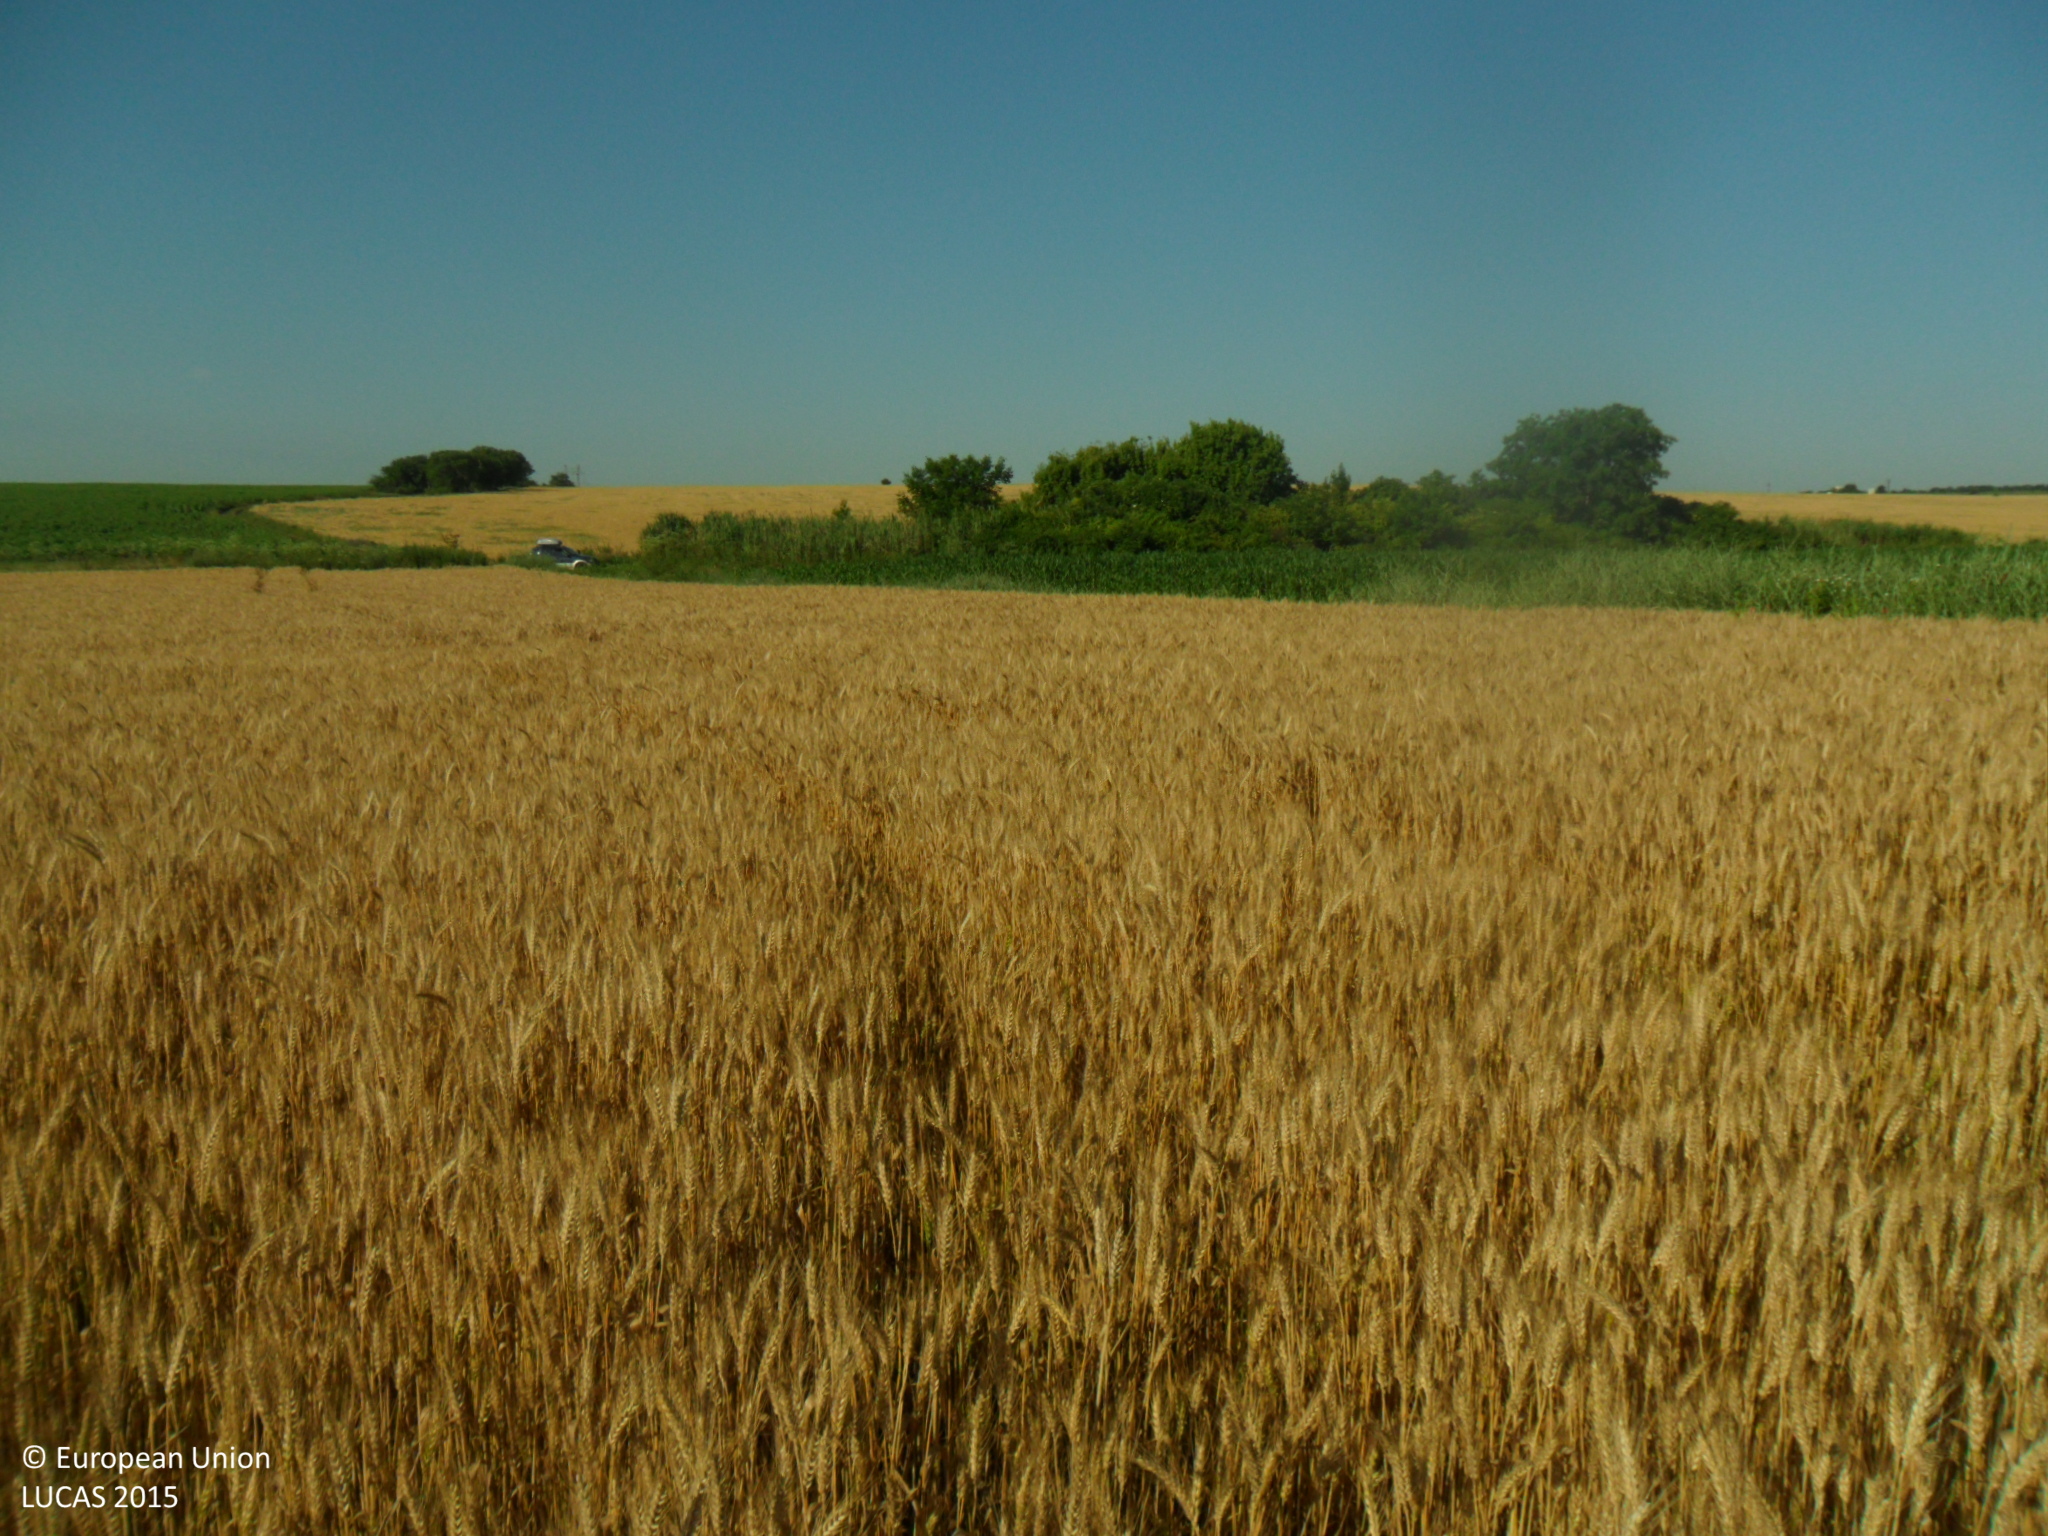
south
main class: Cropland
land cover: Common wheat
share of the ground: > 75 %
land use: Agriculture (excluding fallow land and kitchen gardens)
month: June
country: BG
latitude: 43.3275
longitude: 27.0743
